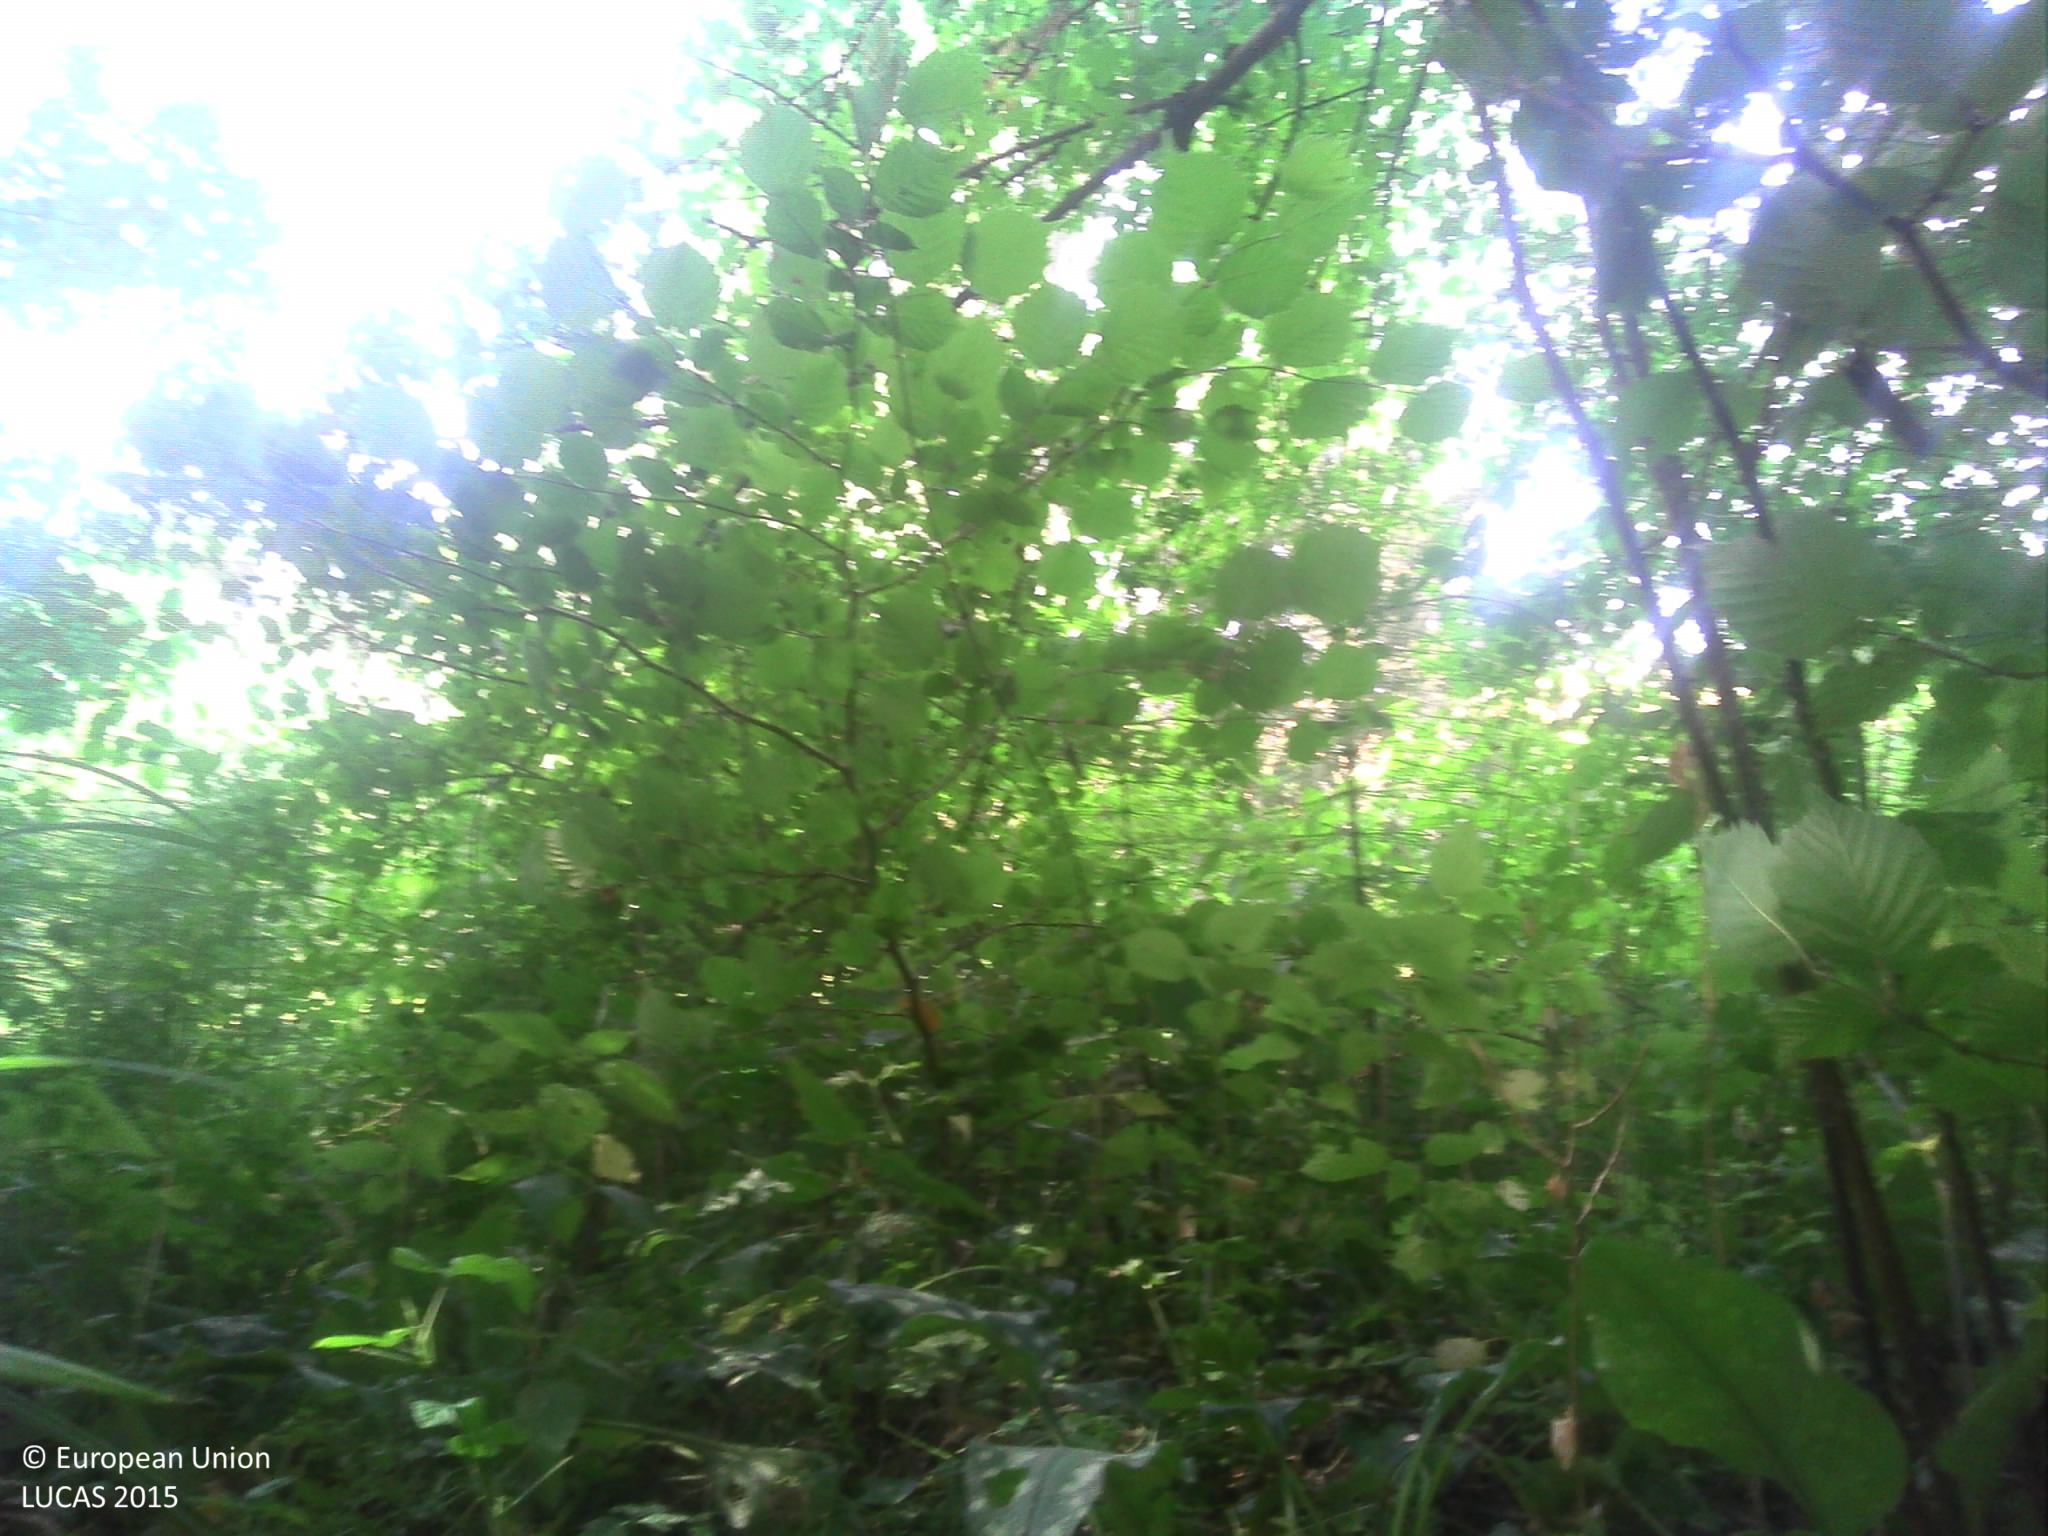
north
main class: Woodland
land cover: Broadleaved woodland
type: acidophilous oak and oak-birch forest
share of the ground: > 75 %
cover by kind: broadleaved forest trees 65 %, herbaceous plants 35 %
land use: Forestry
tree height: > 5 m
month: July
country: FR
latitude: 43.6099
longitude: 1.5904
